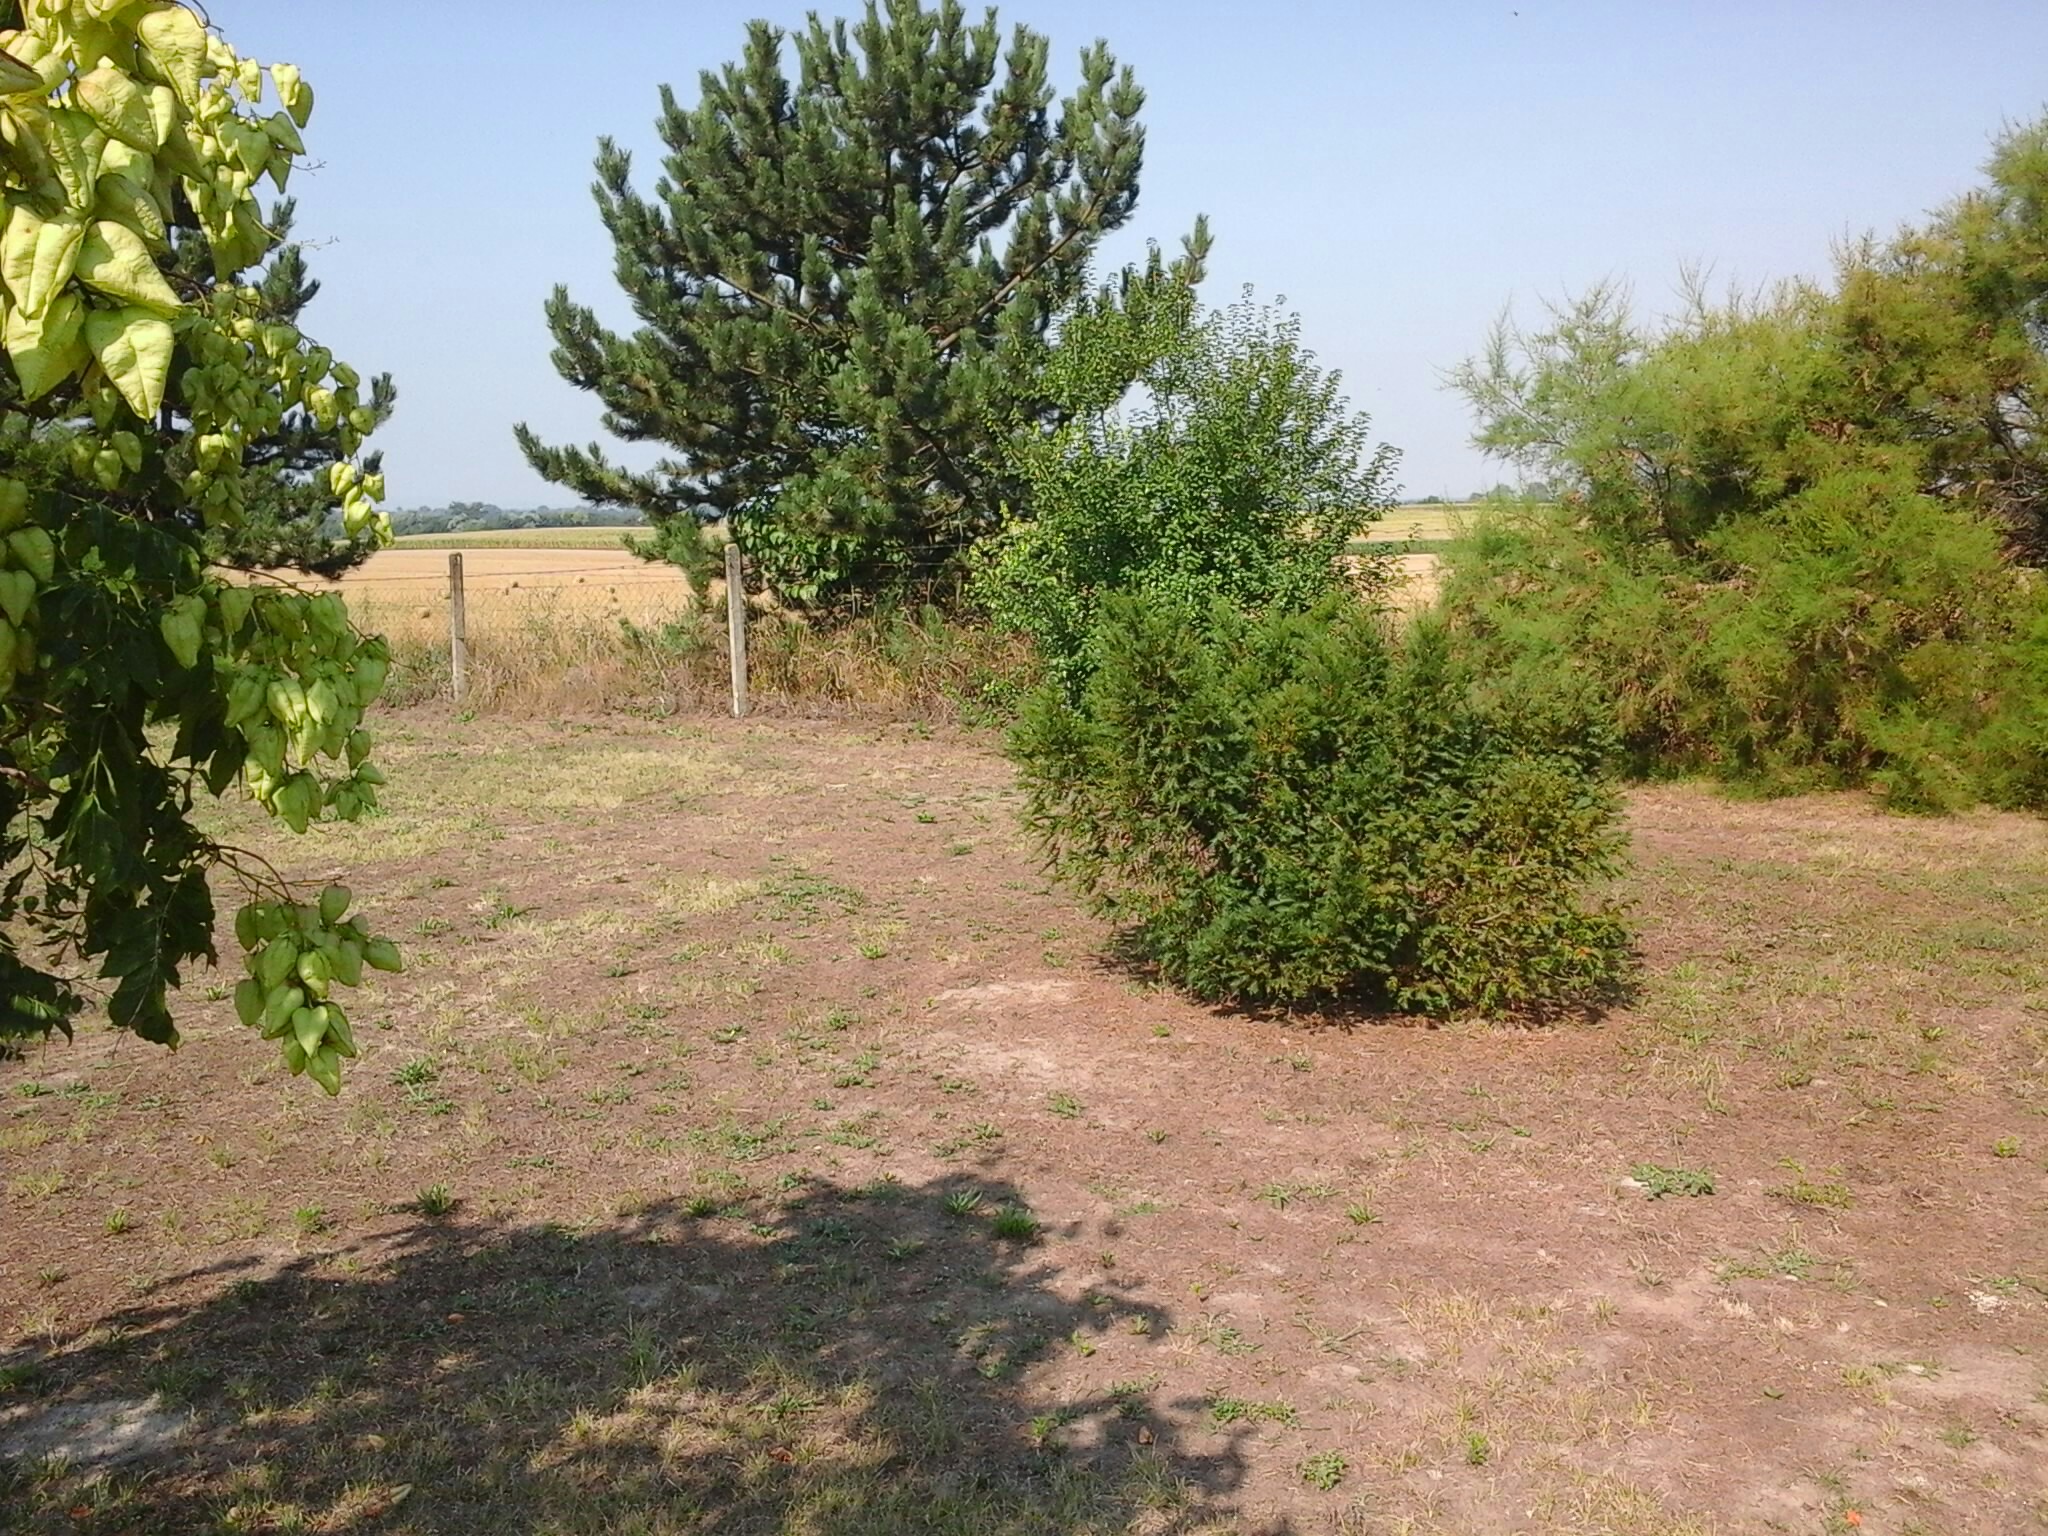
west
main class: Grassland
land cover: Grassland without tree/shrub cover
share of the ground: > 75 %
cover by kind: herbaceous plants 95 %, shrubs 5 %
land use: Community services
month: August
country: HU
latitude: 47.6462
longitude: 17.9583
